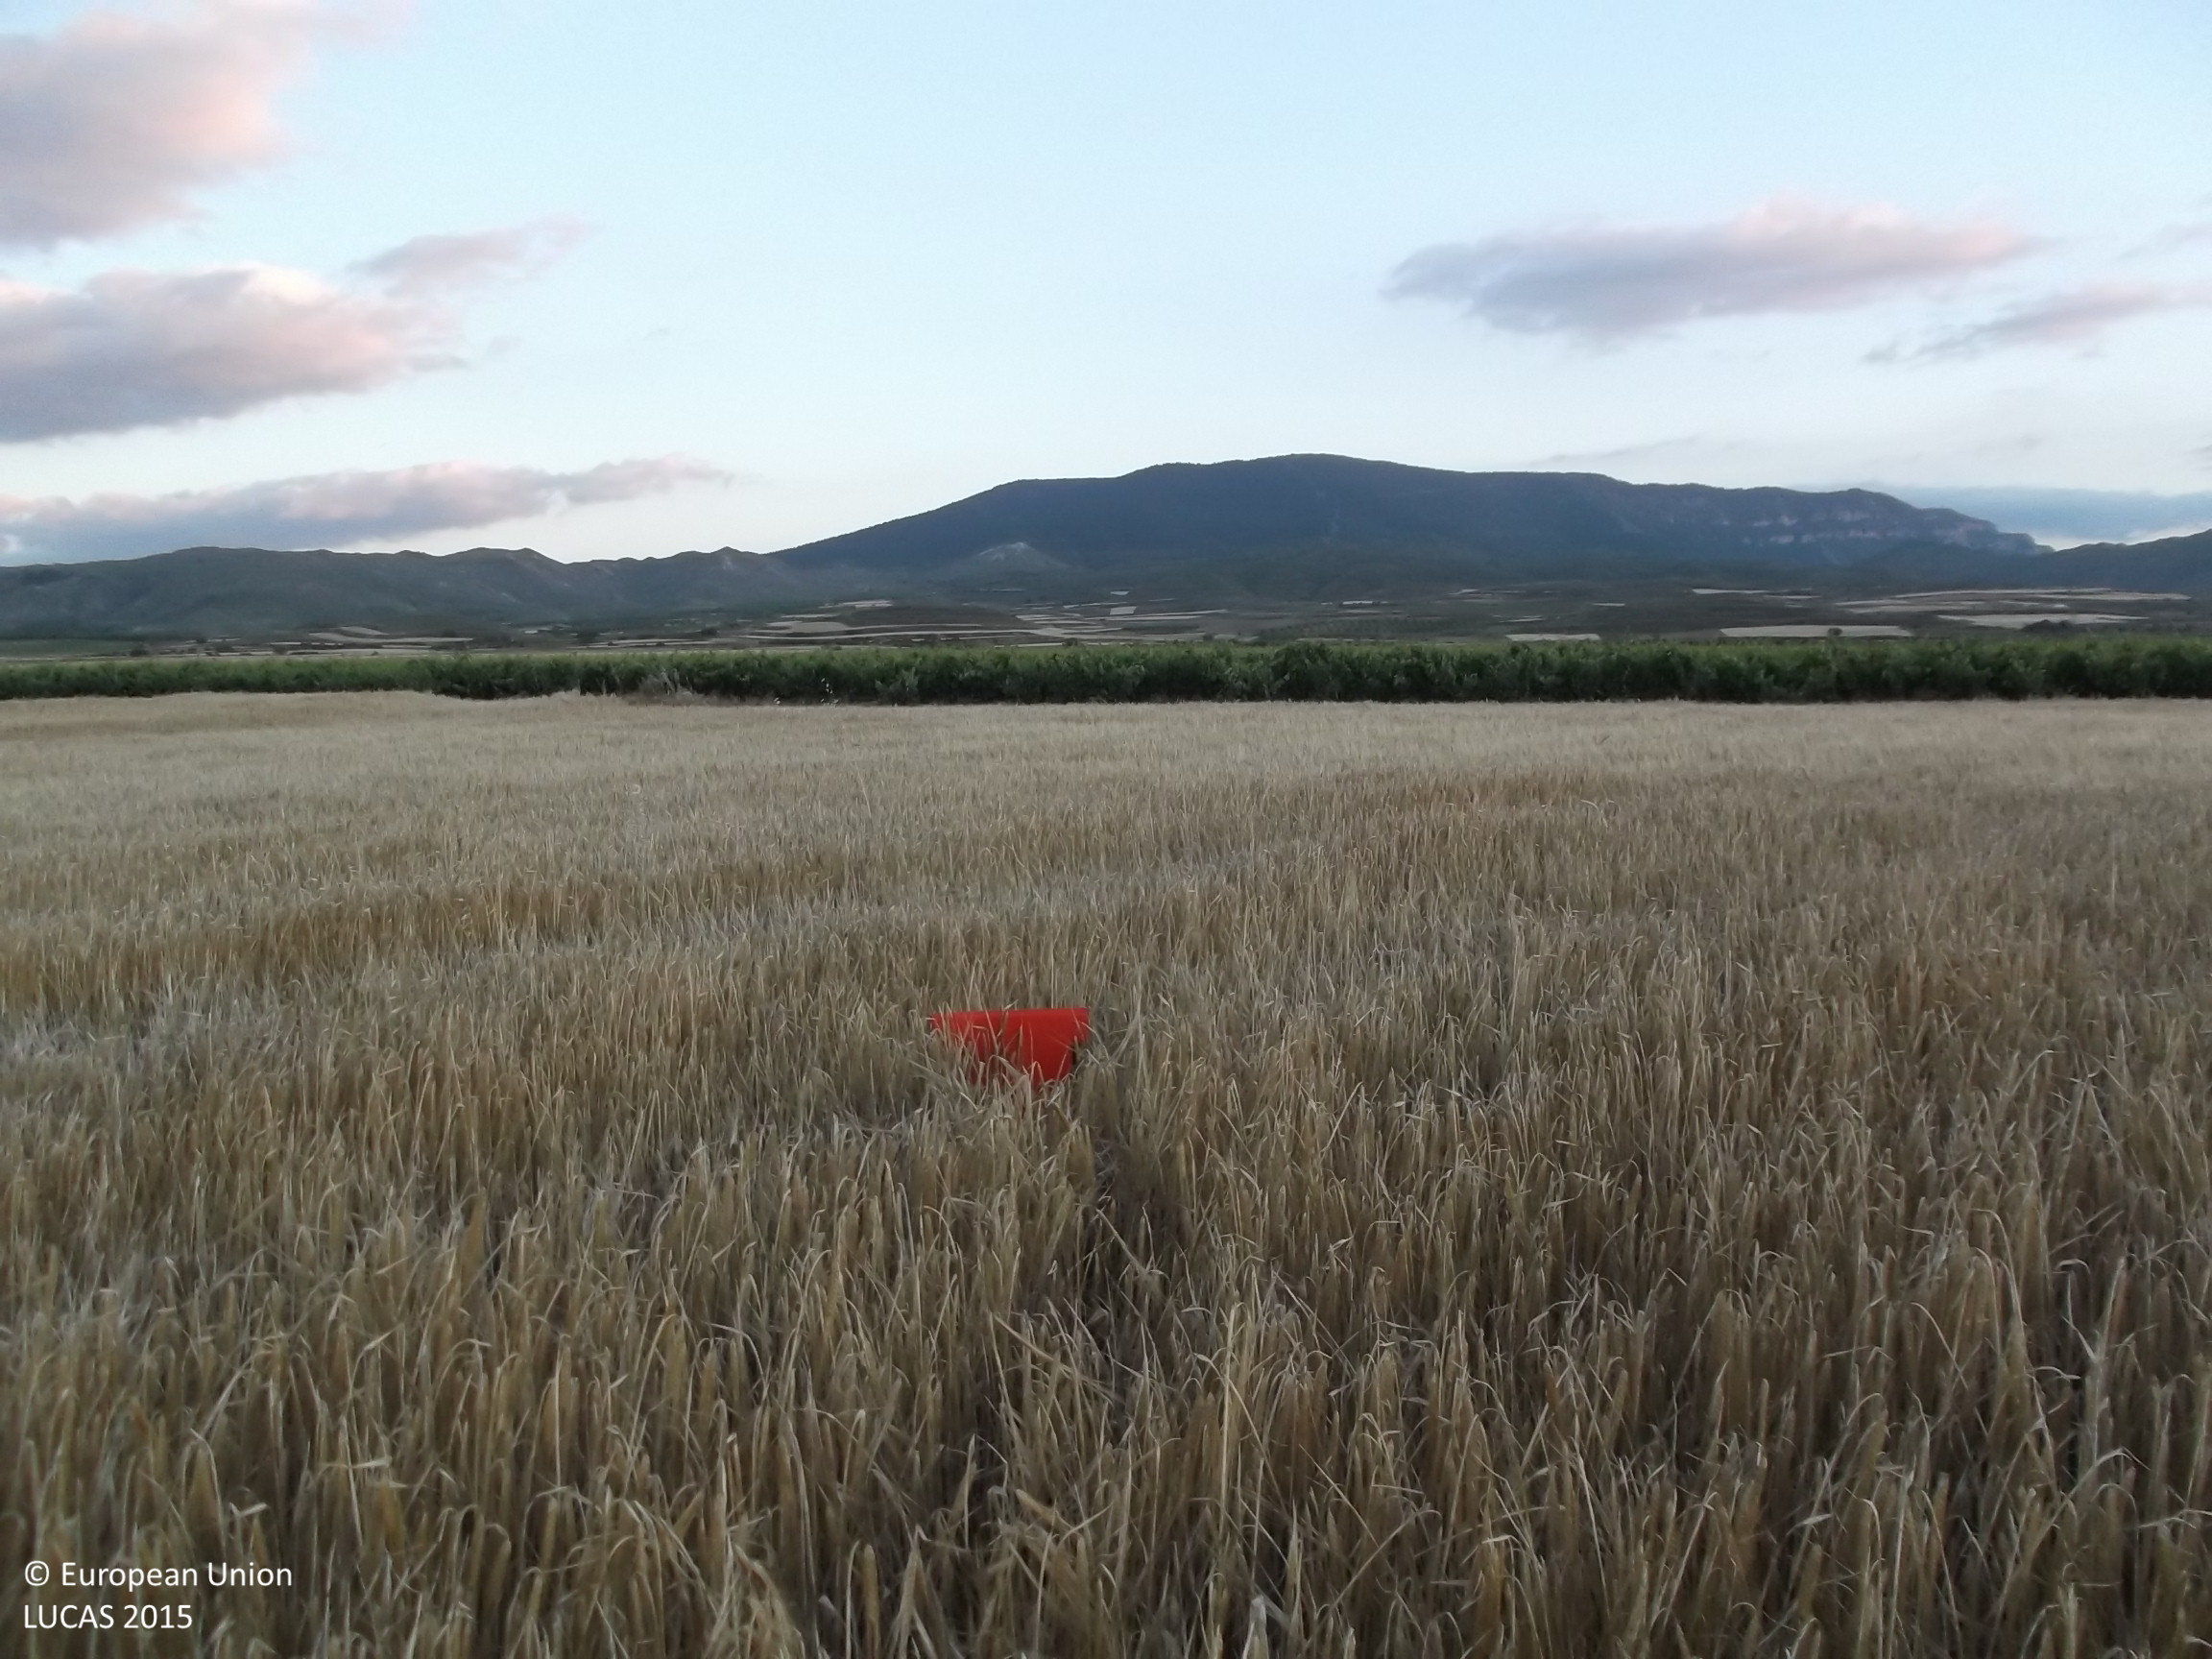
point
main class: Cropland
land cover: Barley
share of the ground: > 75 %
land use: Agriculture (excluding fallow land and kitchen gardens)
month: June
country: ES
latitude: 42.3703
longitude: -2.3440
